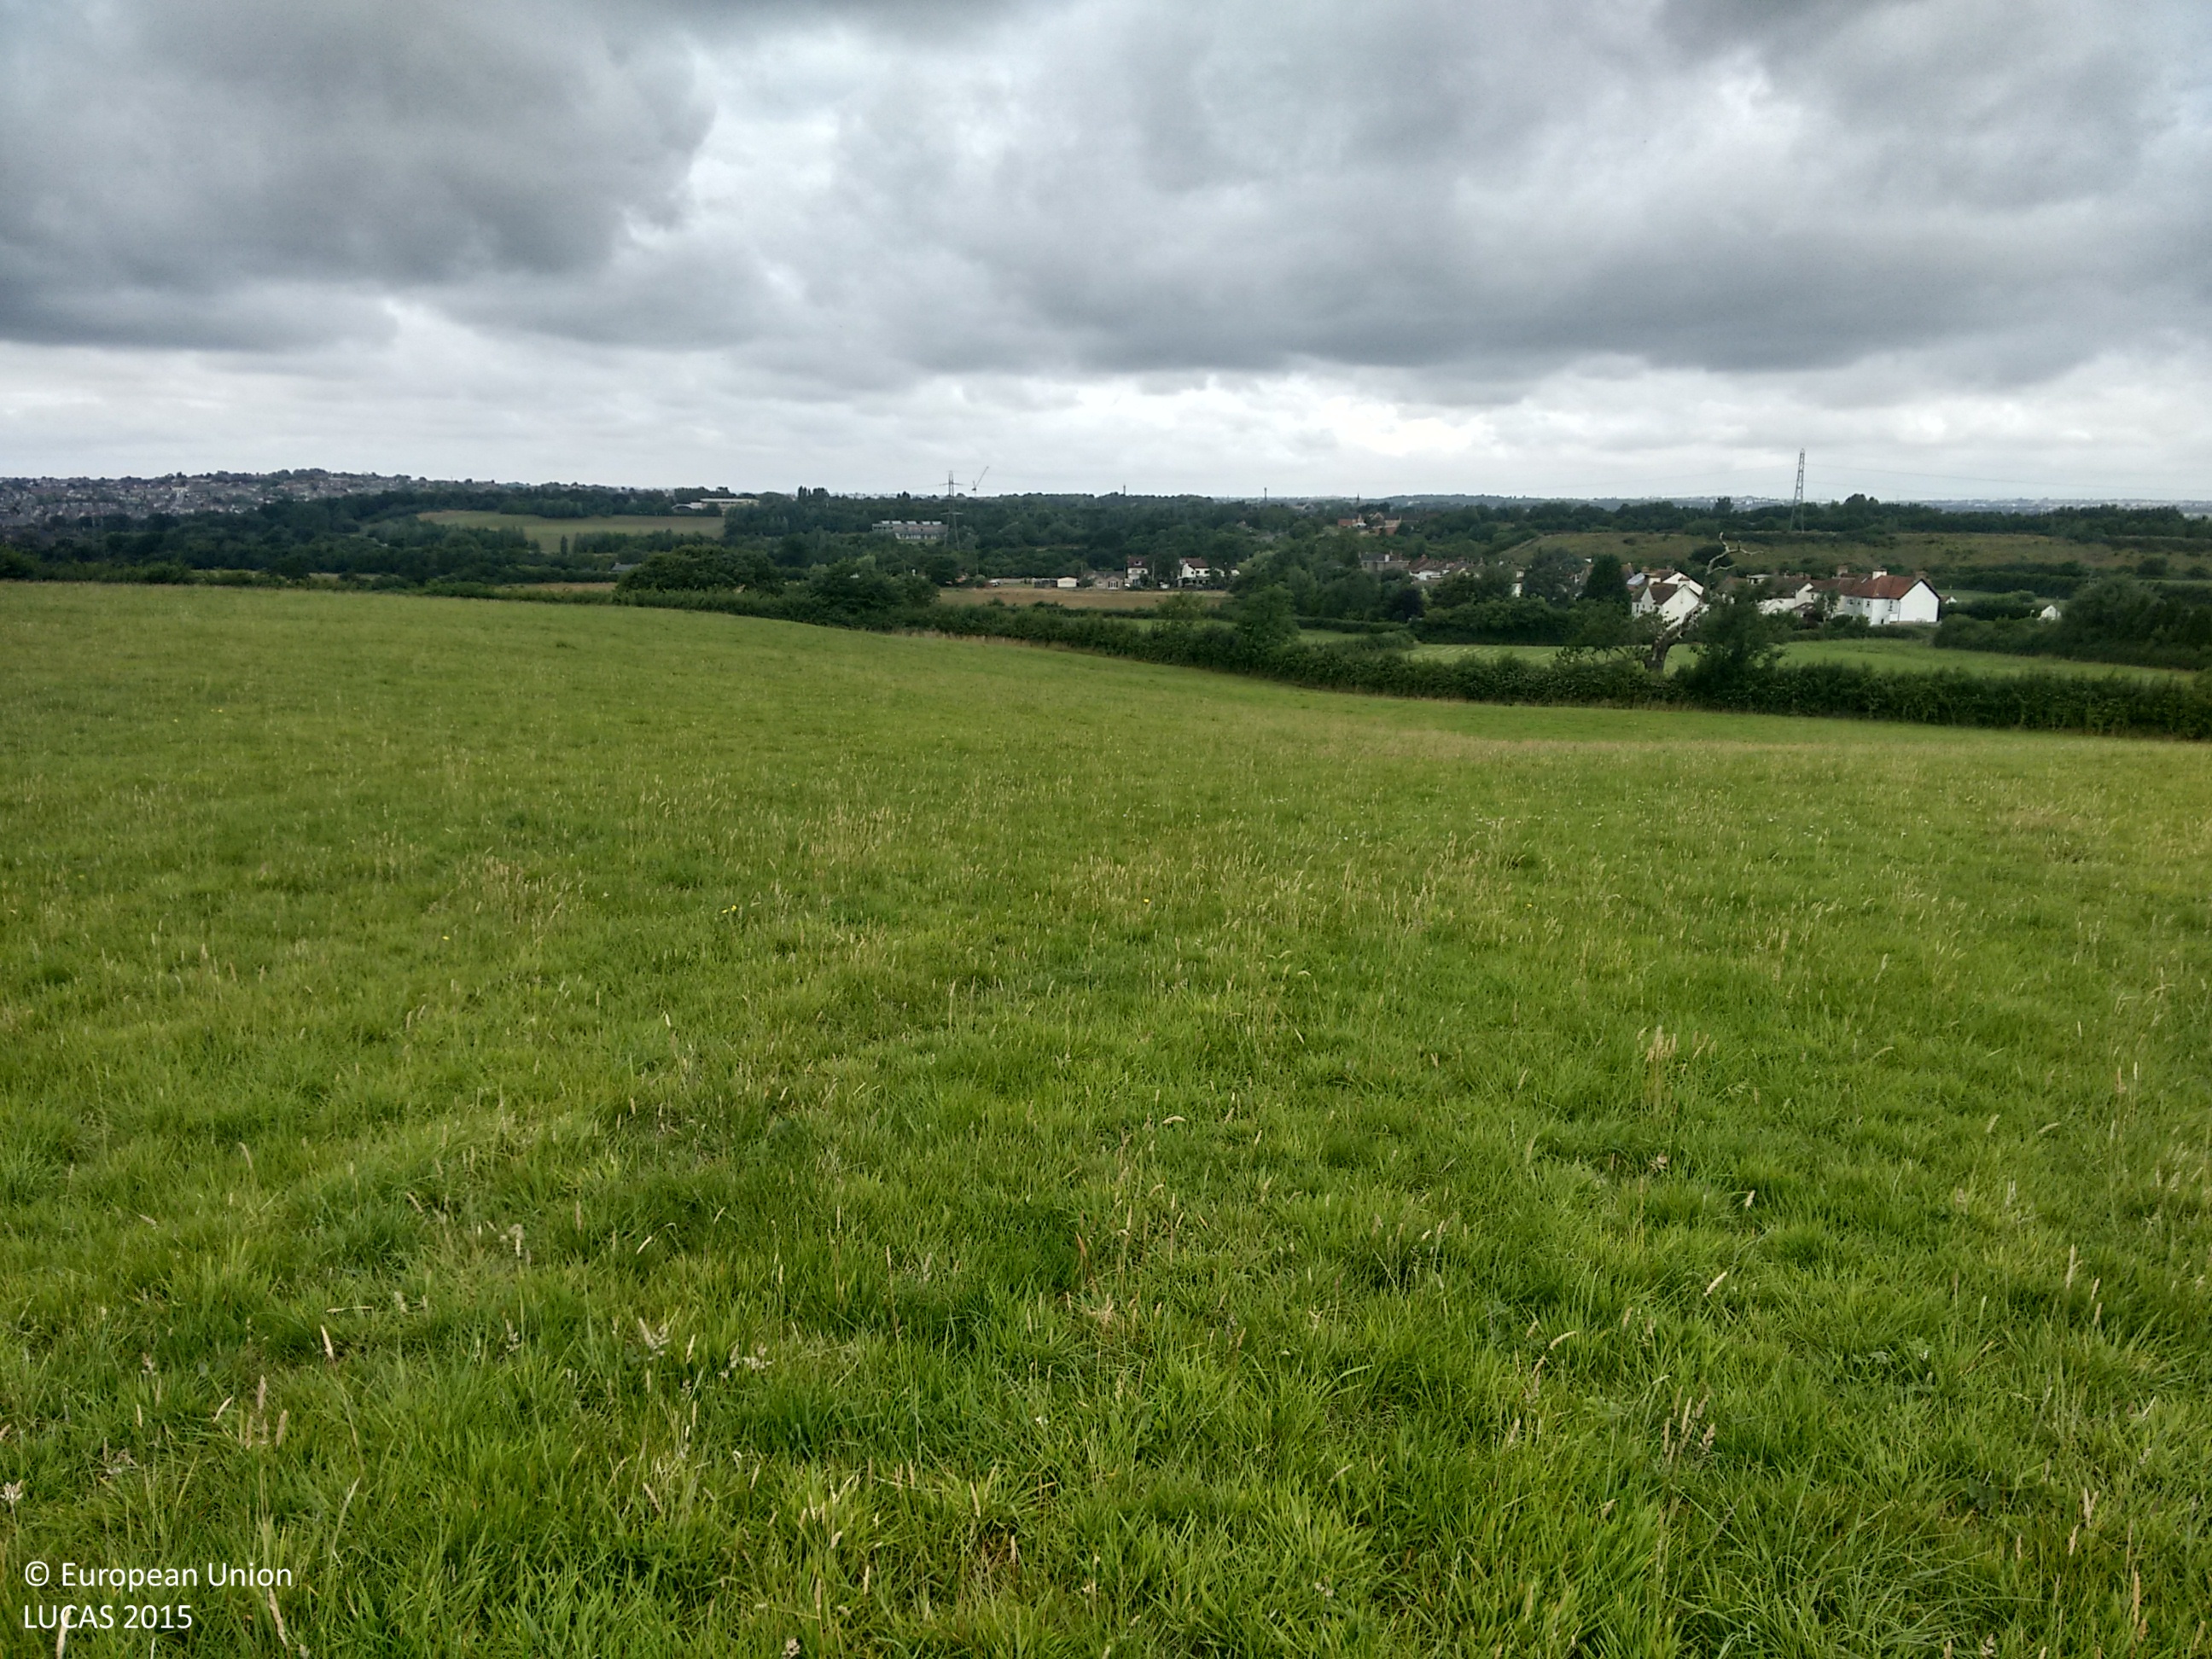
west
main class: Grassland
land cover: Grassland without tree/shrub cover
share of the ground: > 75 %
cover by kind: herbaceous plants 100 %
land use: Agriculture (excluding fallow land and kitchen gardens)
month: July
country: GB
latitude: 51.4808
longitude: -2.4638
